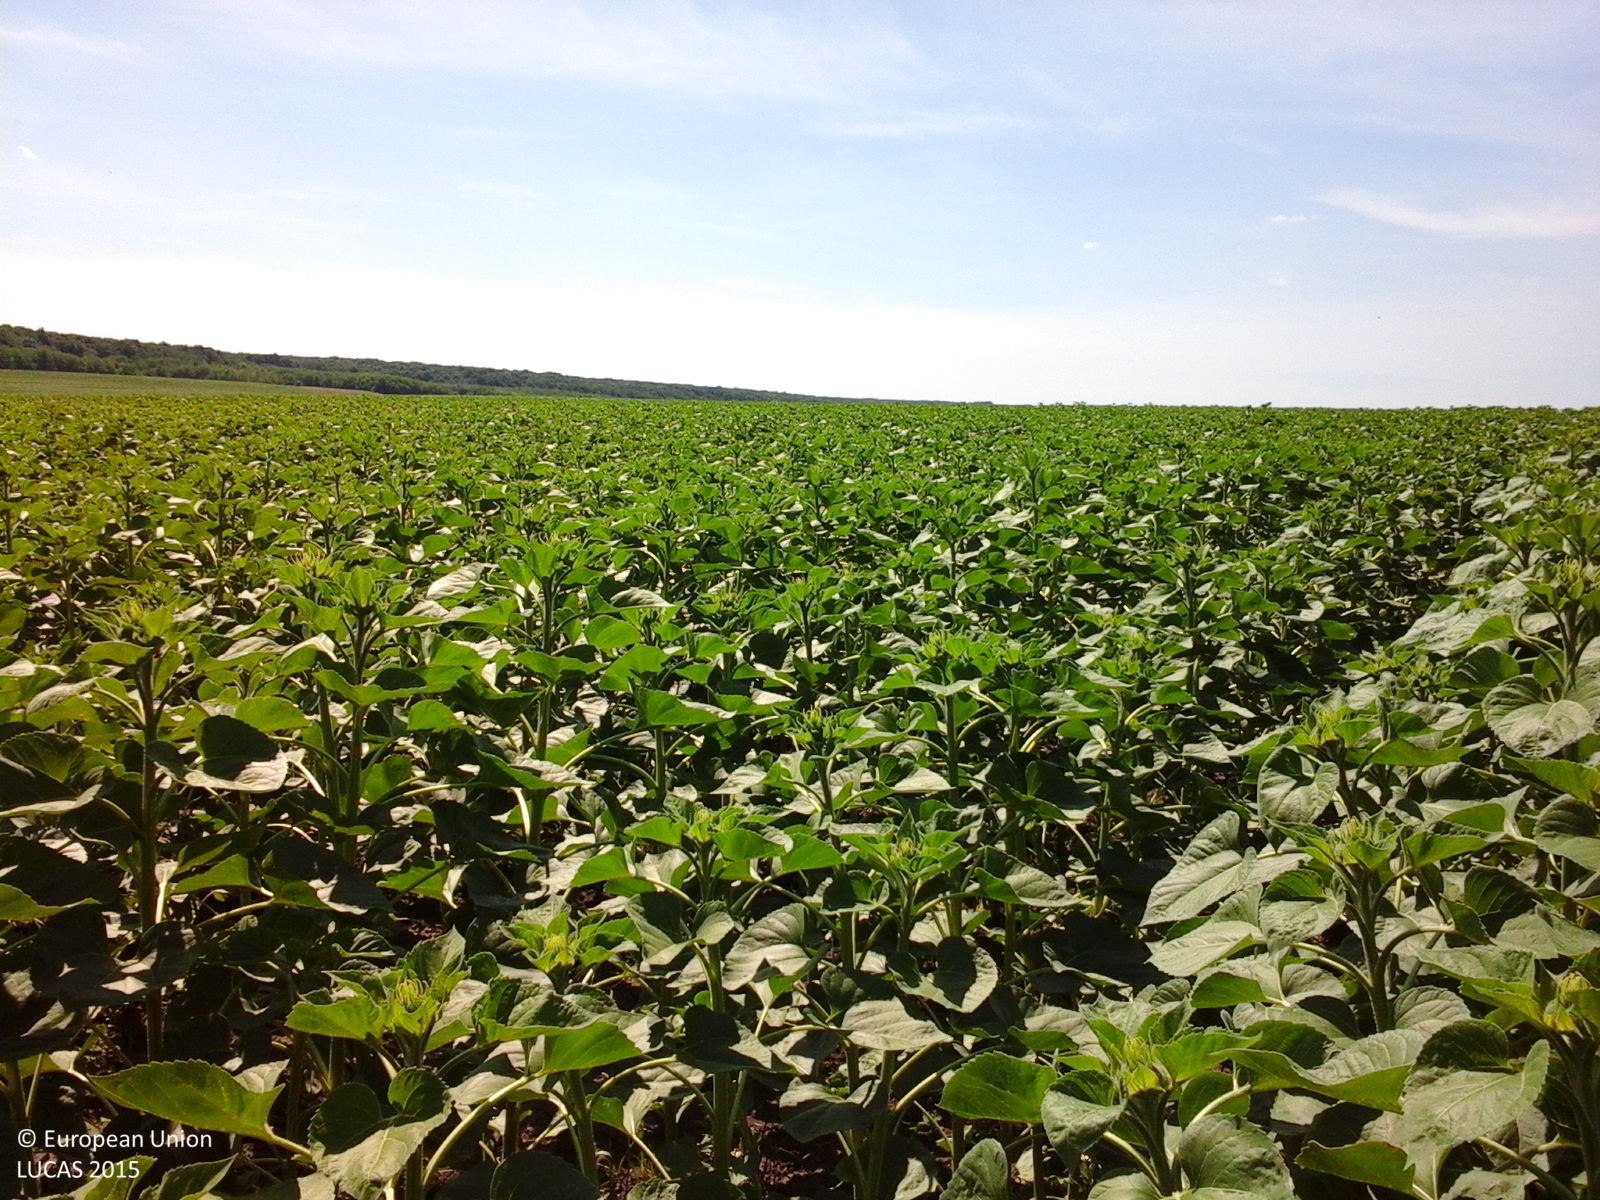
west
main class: Cropland
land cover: Sunflower
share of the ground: > 75 %
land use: Agriculture (excluding fallow land and kitchen gardens)
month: June
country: RO
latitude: 48.0881
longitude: 26.9822
